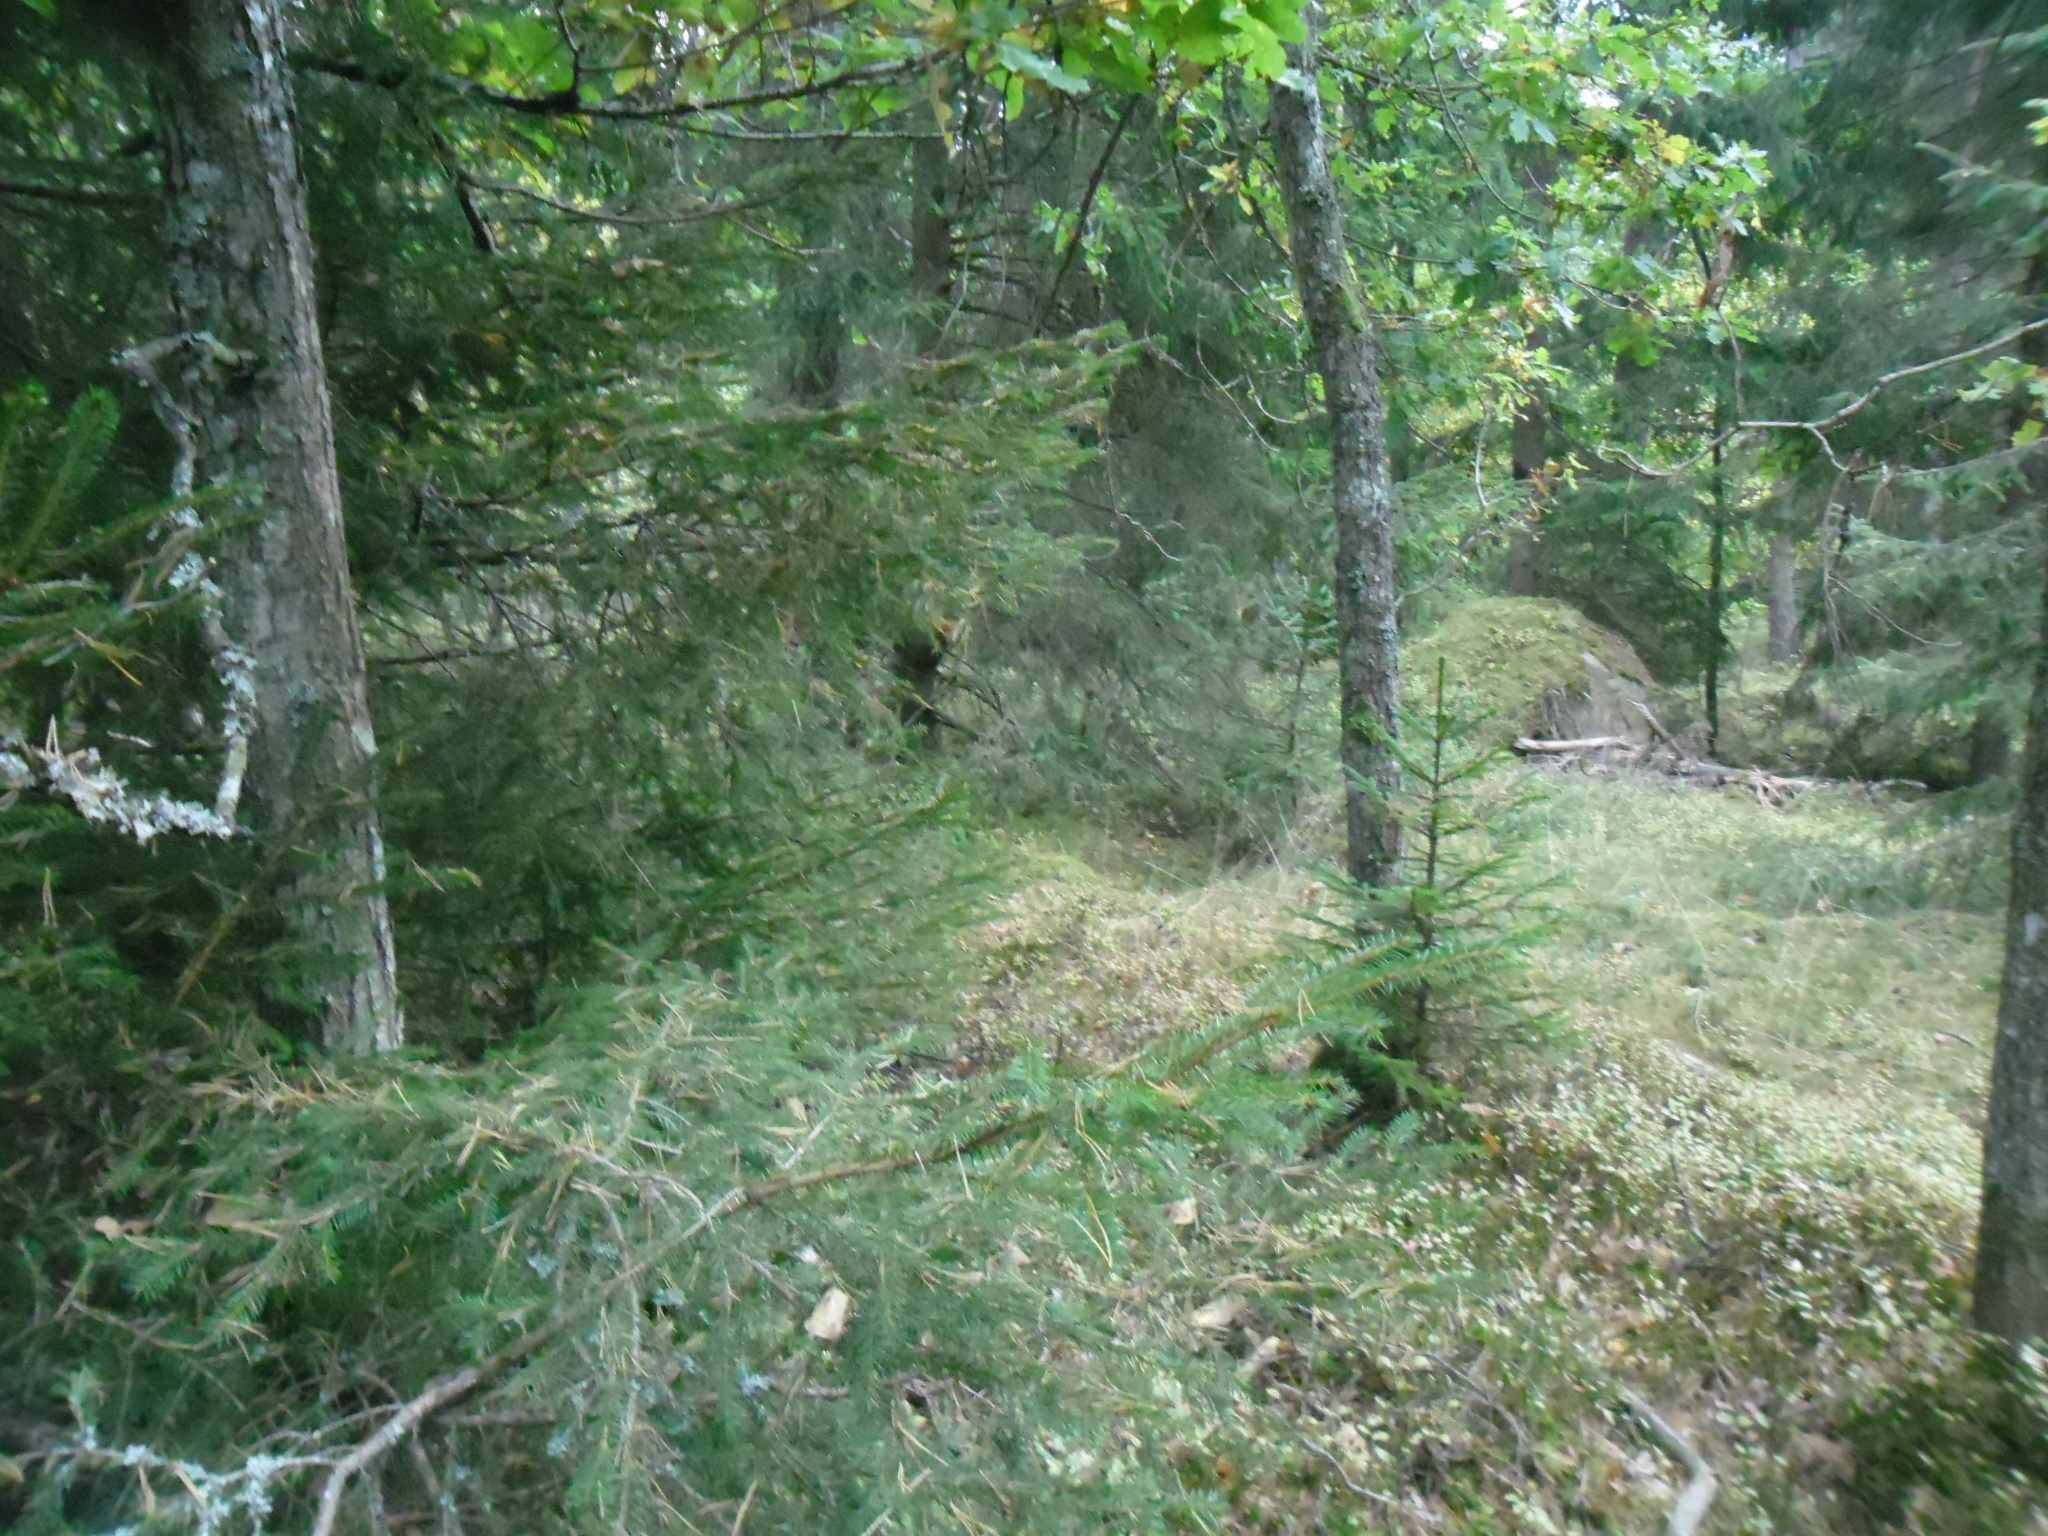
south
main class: Woodland
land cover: Spruce dominated mixed woodland
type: hemiboreal forest and nemoral coniferous forest and mixed broadleaved-coniferous forest
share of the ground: 50 - 75 %
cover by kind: coniferous forest trees 45 %, shrubs 30 %, broadleaved forest trees 15 %, herbaceous plants 10 %
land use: Forestry
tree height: > 5 m
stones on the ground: 25 - 50 %
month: October
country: SE
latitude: 56.3655
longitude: 13.8014
